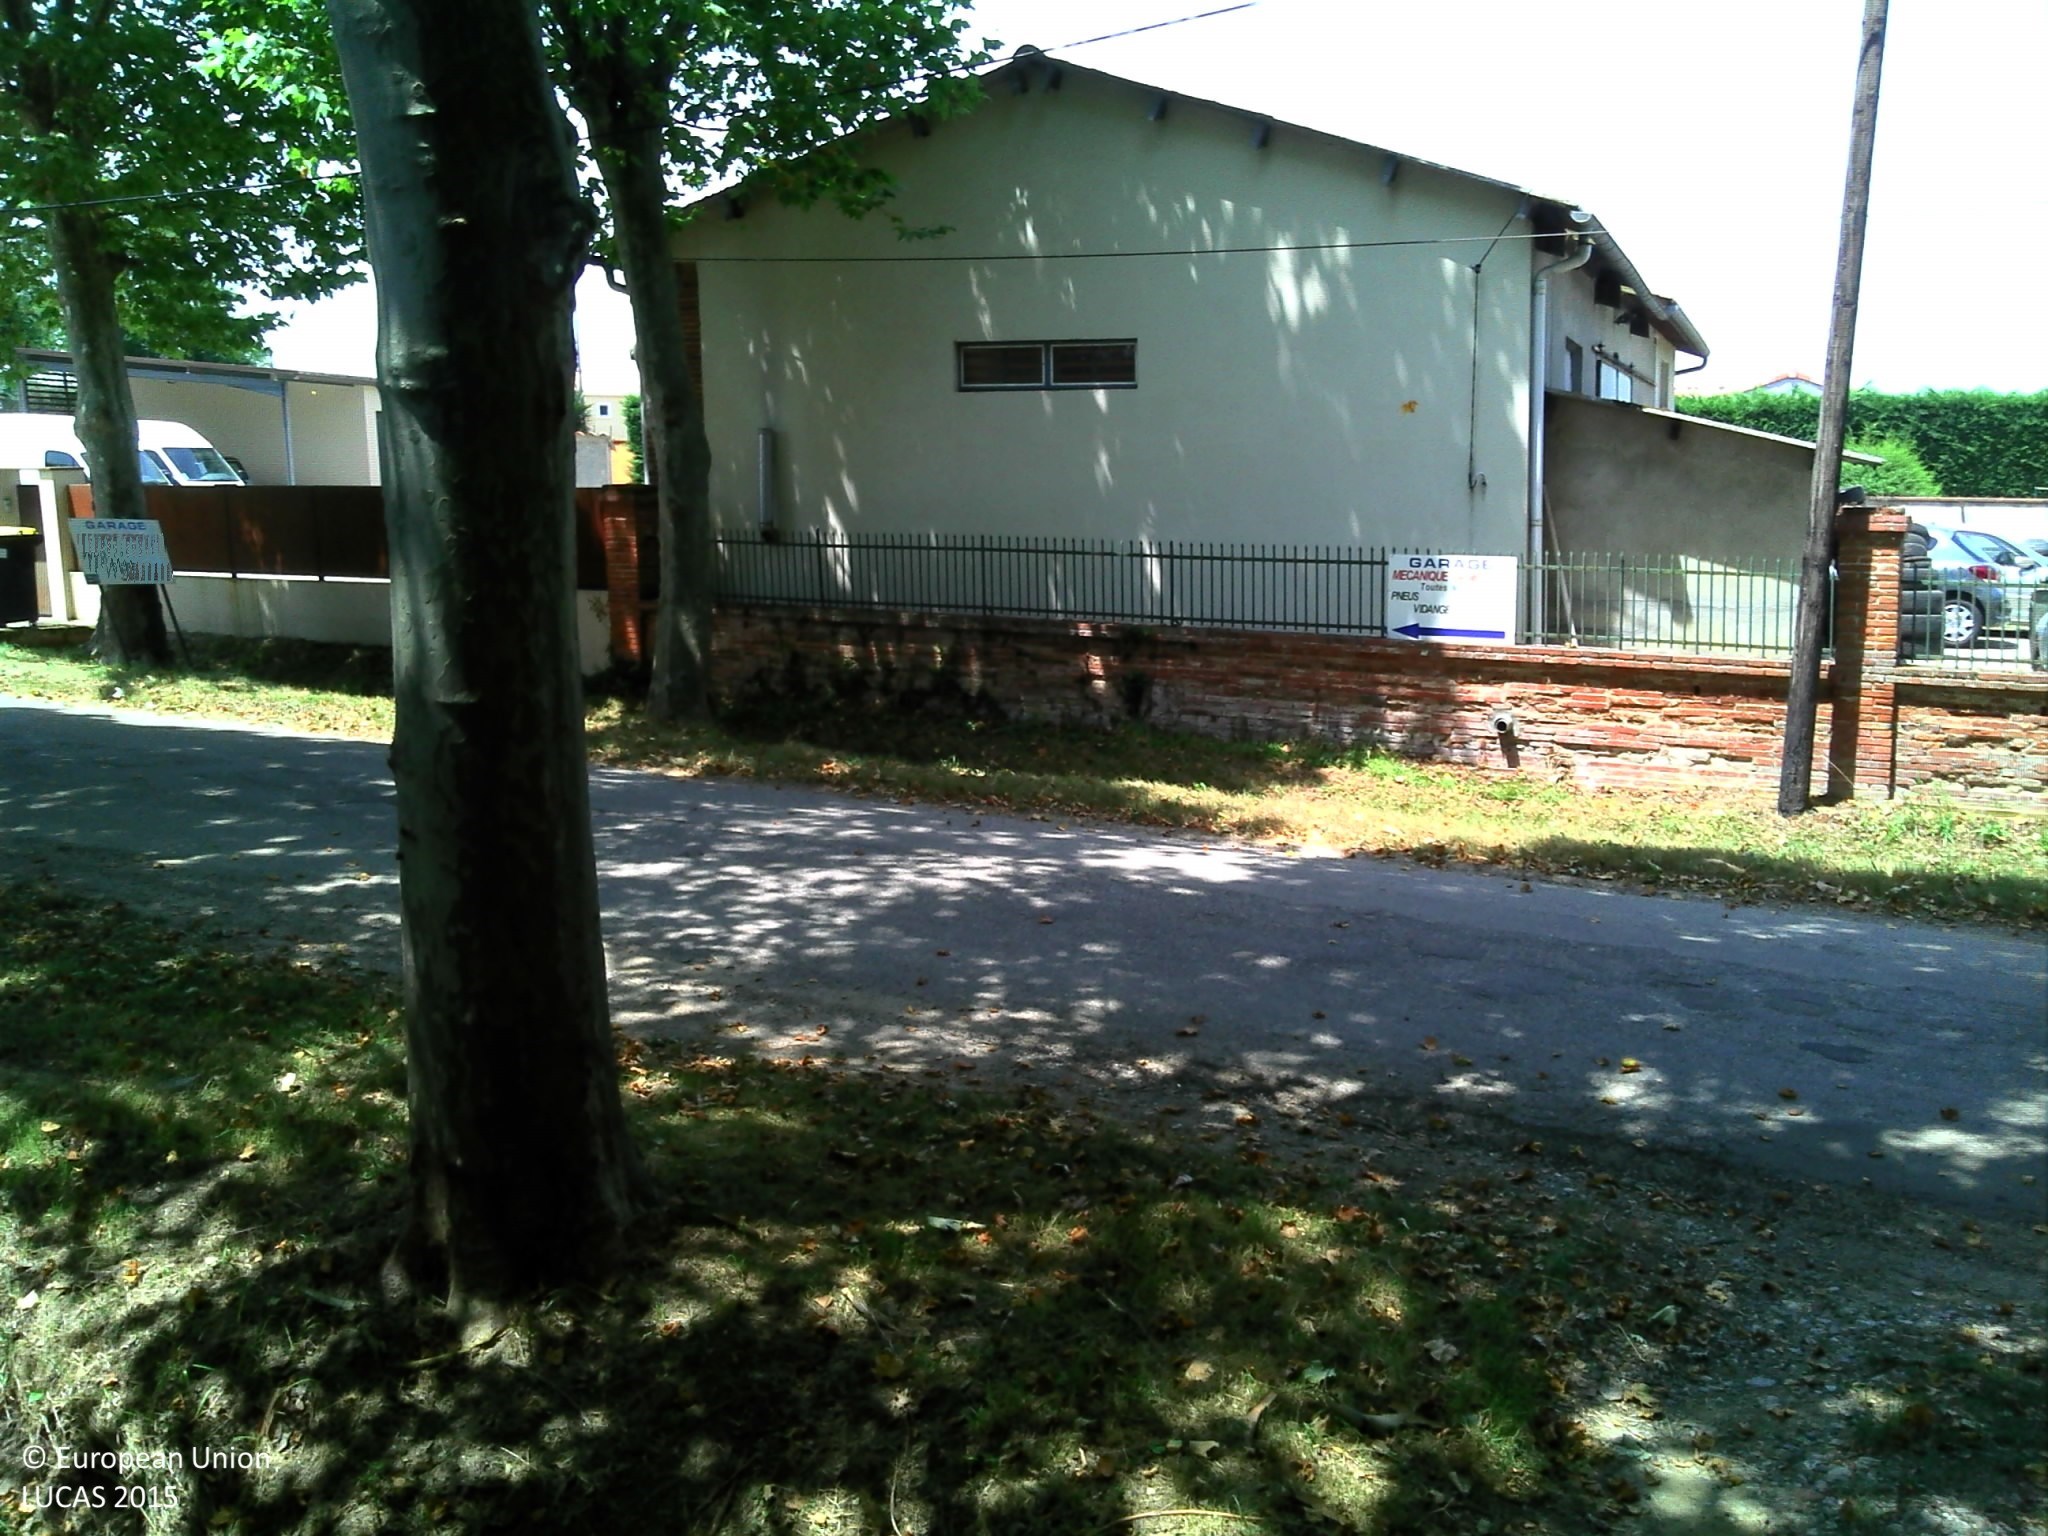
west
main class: Grassland
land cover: Grassland with sparse tree/shrub cover
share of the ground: > 75 %
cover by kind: herbaceous plants 95 %, broadleaved forest trees 5 %
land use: Residential
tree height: > 5 m
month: July
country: FR
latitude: 43.6816
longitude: 1.5800
